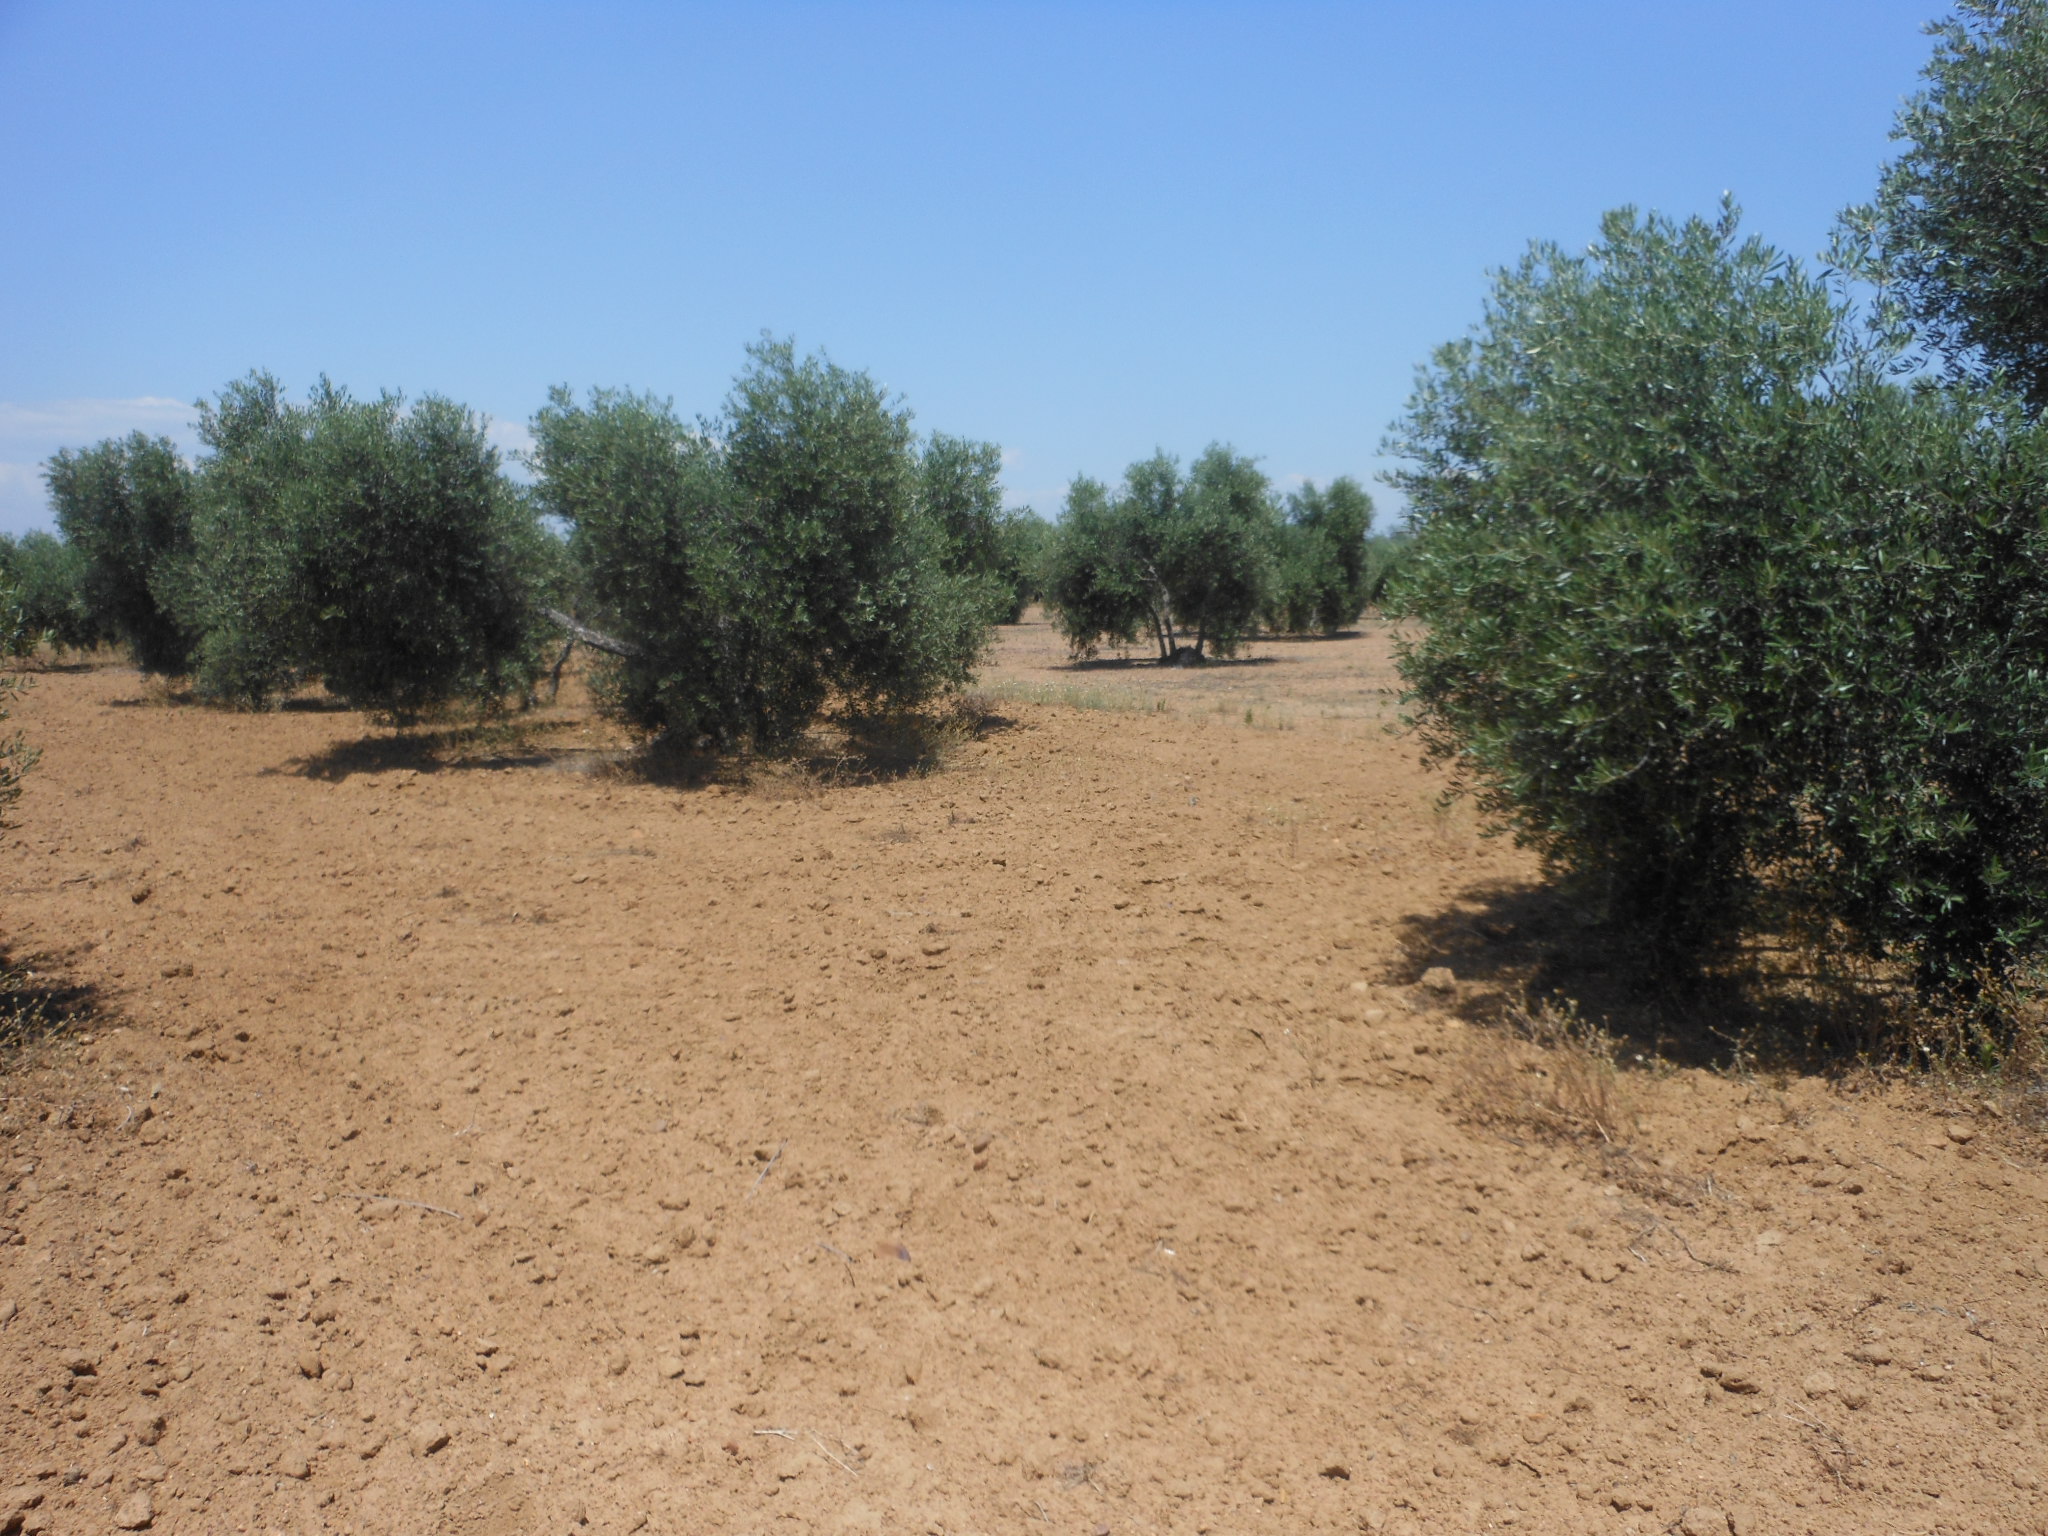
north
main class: Cropland
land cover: Olive groves
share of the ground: 50 - 75 %
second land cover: Other bare soil
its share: > 75 %
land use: Agriculture (excluding fallow land and kitchen gardens)
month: May
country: ES
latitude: 37.5316
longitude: -5.4188
